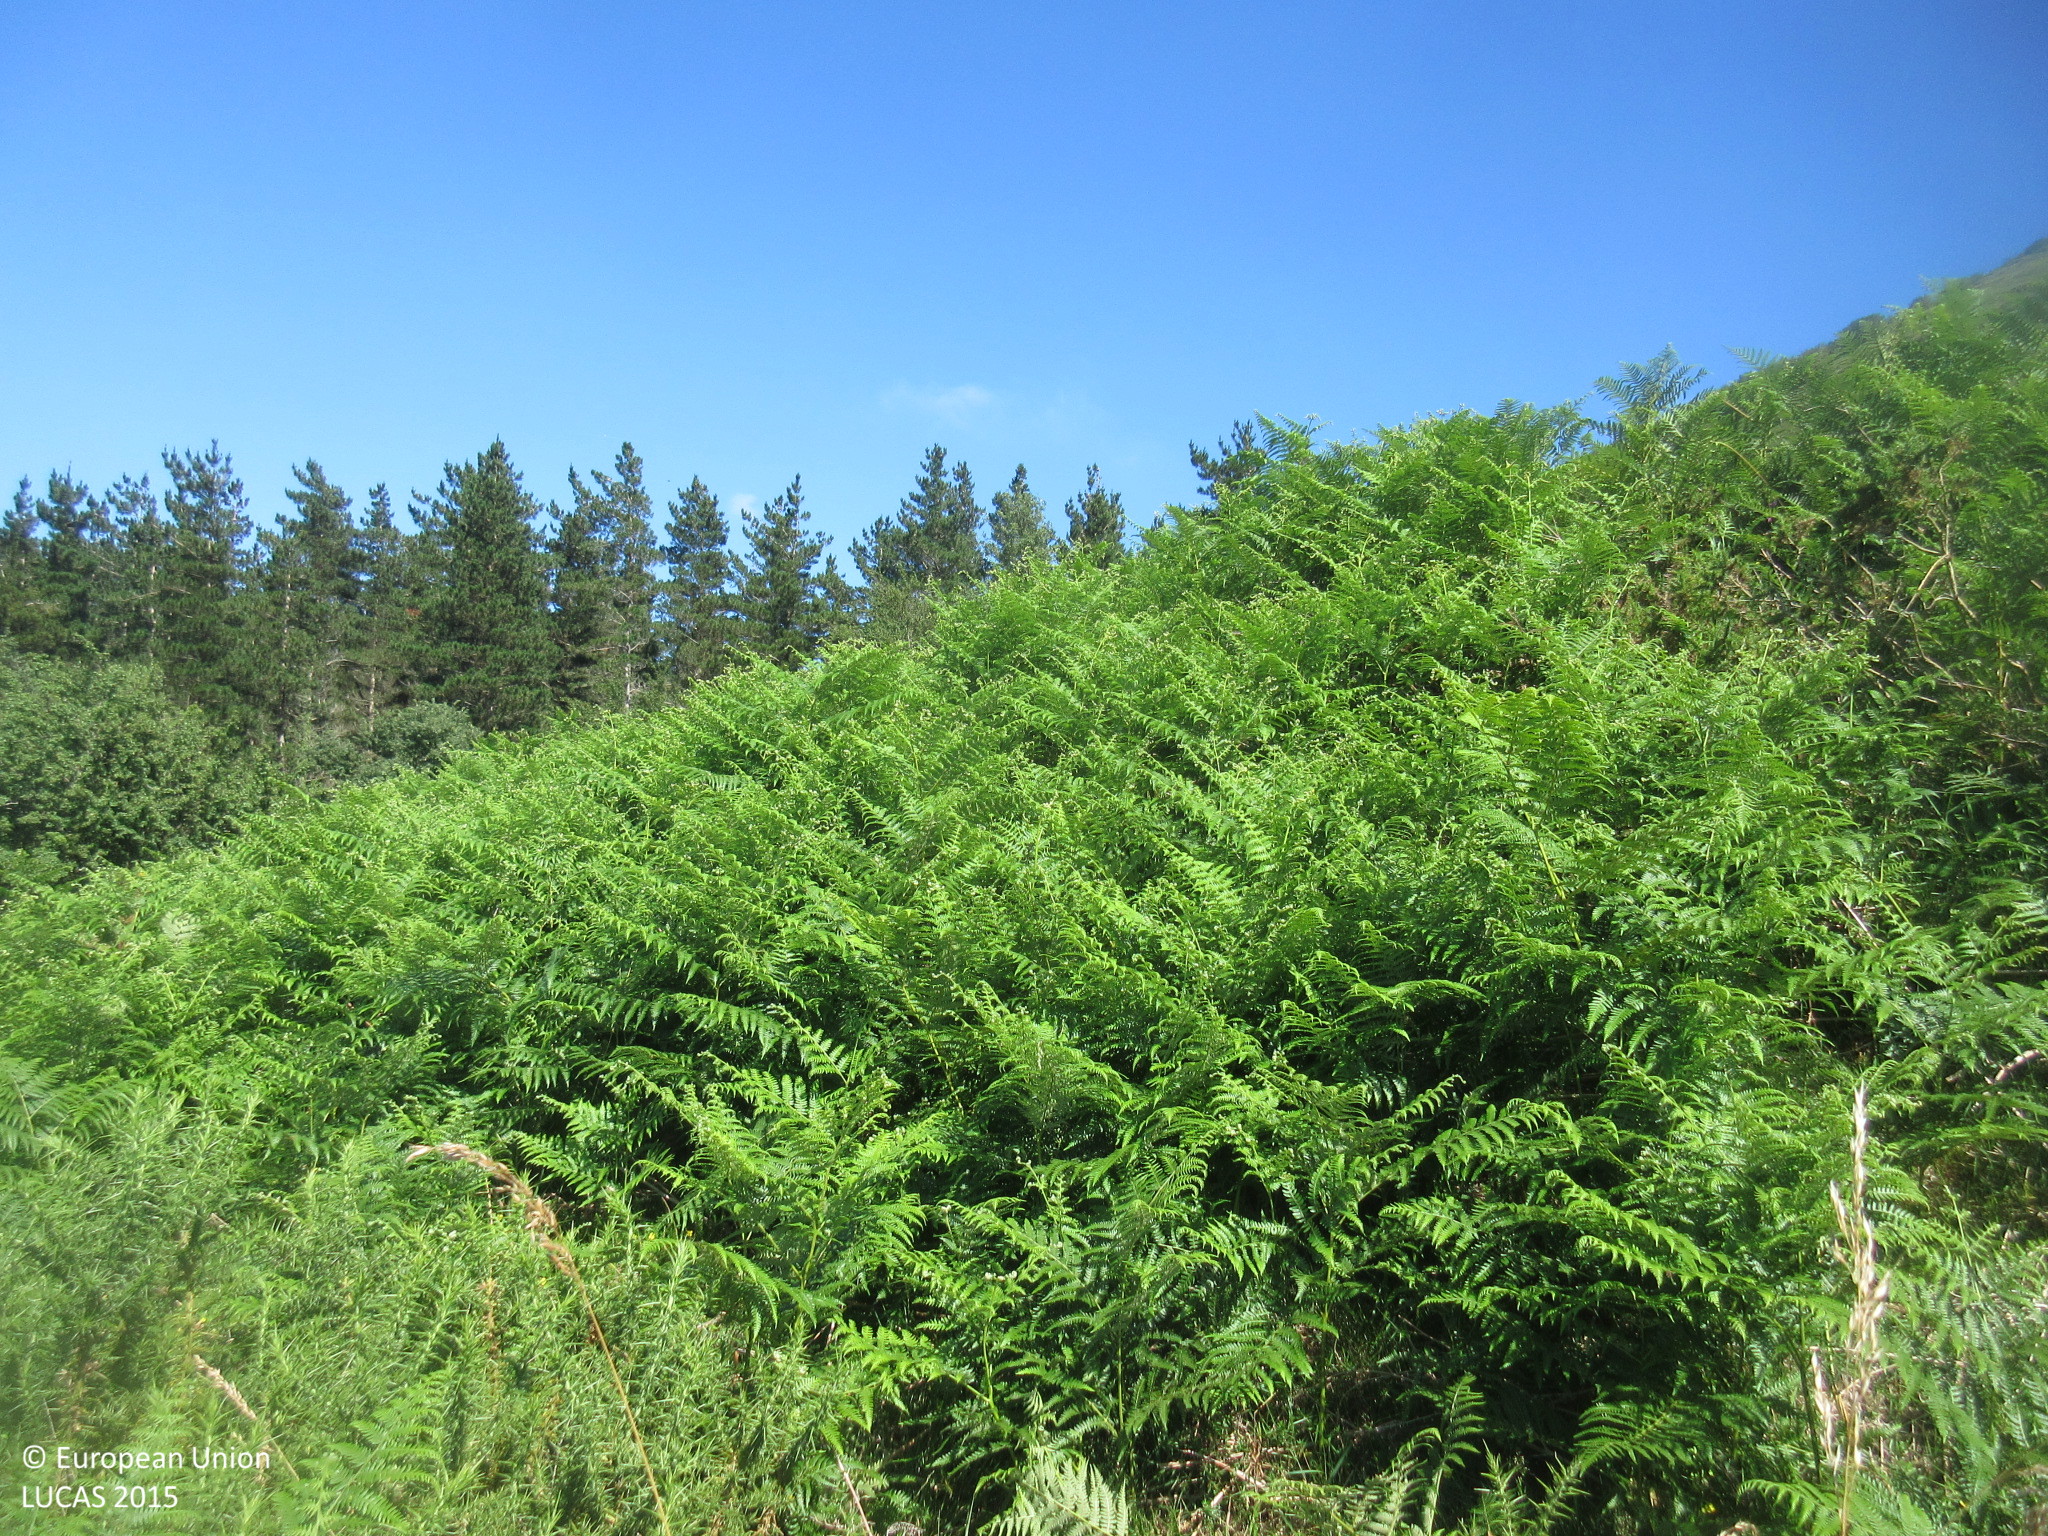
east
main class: Shrubland
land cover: Shrubland with sparse tree cover
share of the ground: > 75 %
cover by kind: shrubs 95 %, broadleaved forest trees 5 %
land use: Forestry
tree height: > 5 m
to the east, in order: Shrubland with sparse tree cover; Broadleaved woodland; Pine dominated coniferous woodland; Tracks; Pine dominated coniferous woodland
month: July
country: ES
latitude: 43.1651
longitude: -3.4099
